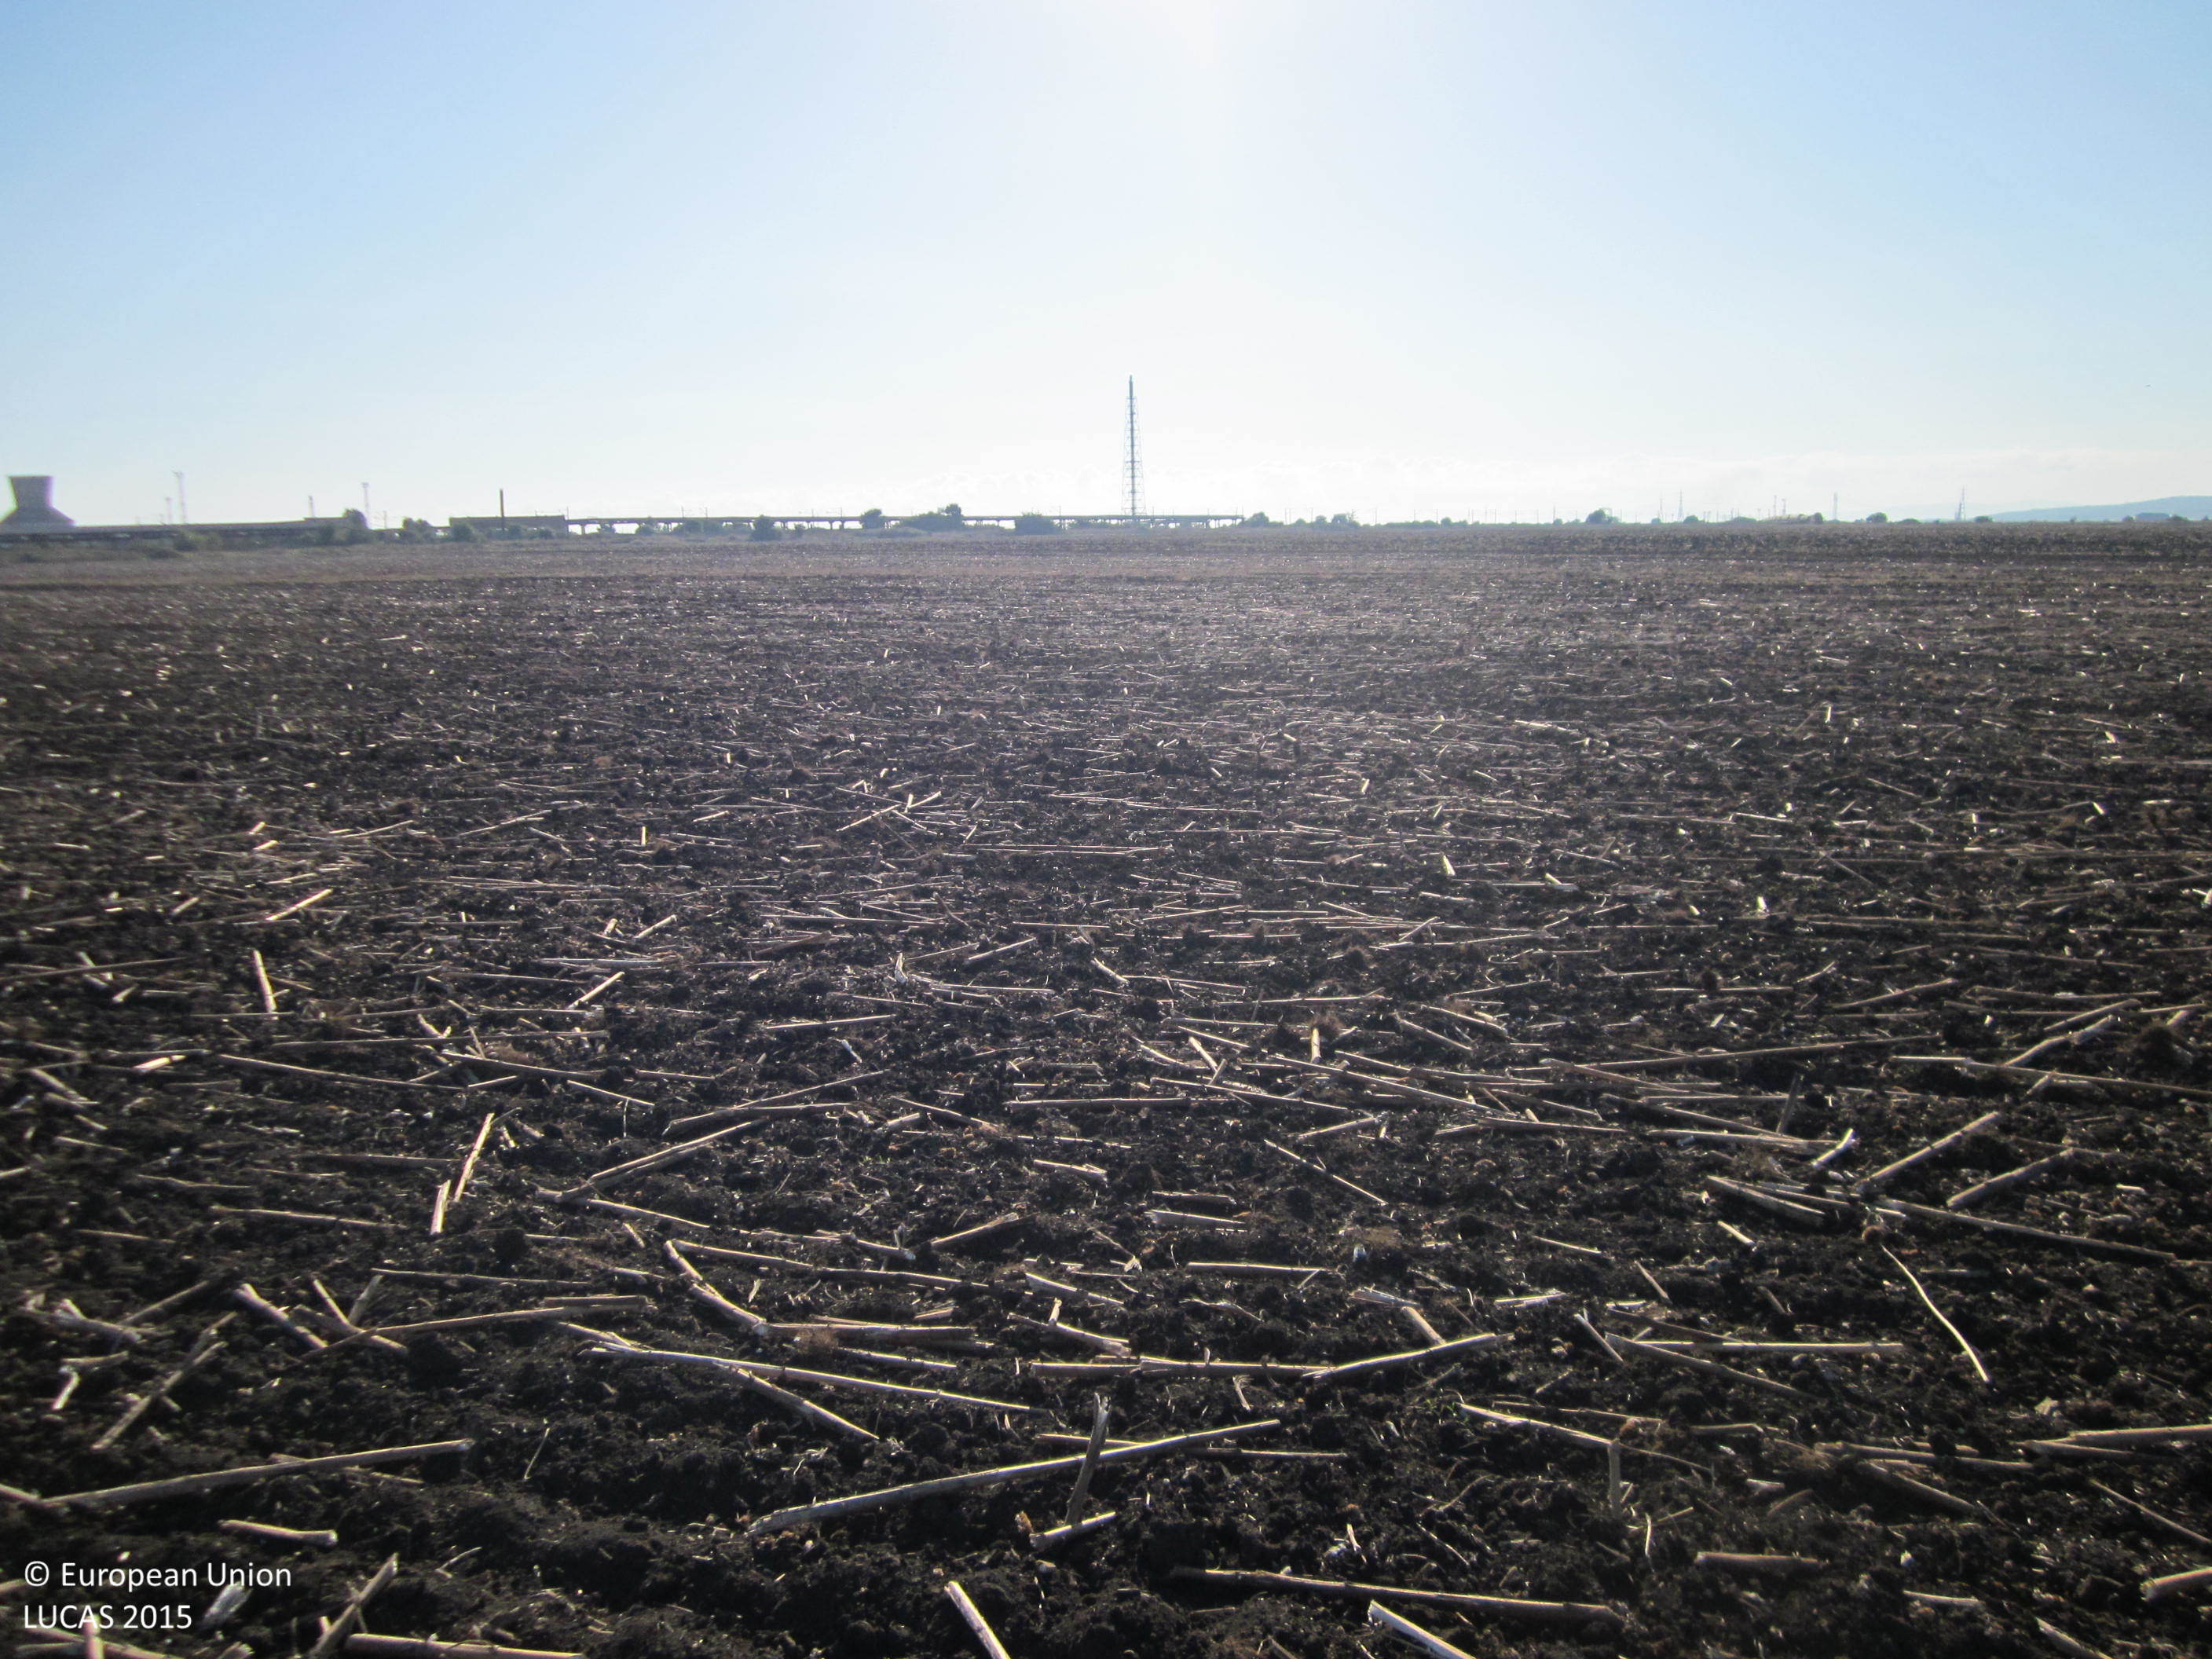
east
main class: Cropland
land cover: Sunflower
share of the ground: < 10 %
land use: Agriculture (excluding fallow land and kitchen gardens)
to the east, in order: Sunflower
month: September
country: BG
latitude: 42.5270
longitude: 27.3397
